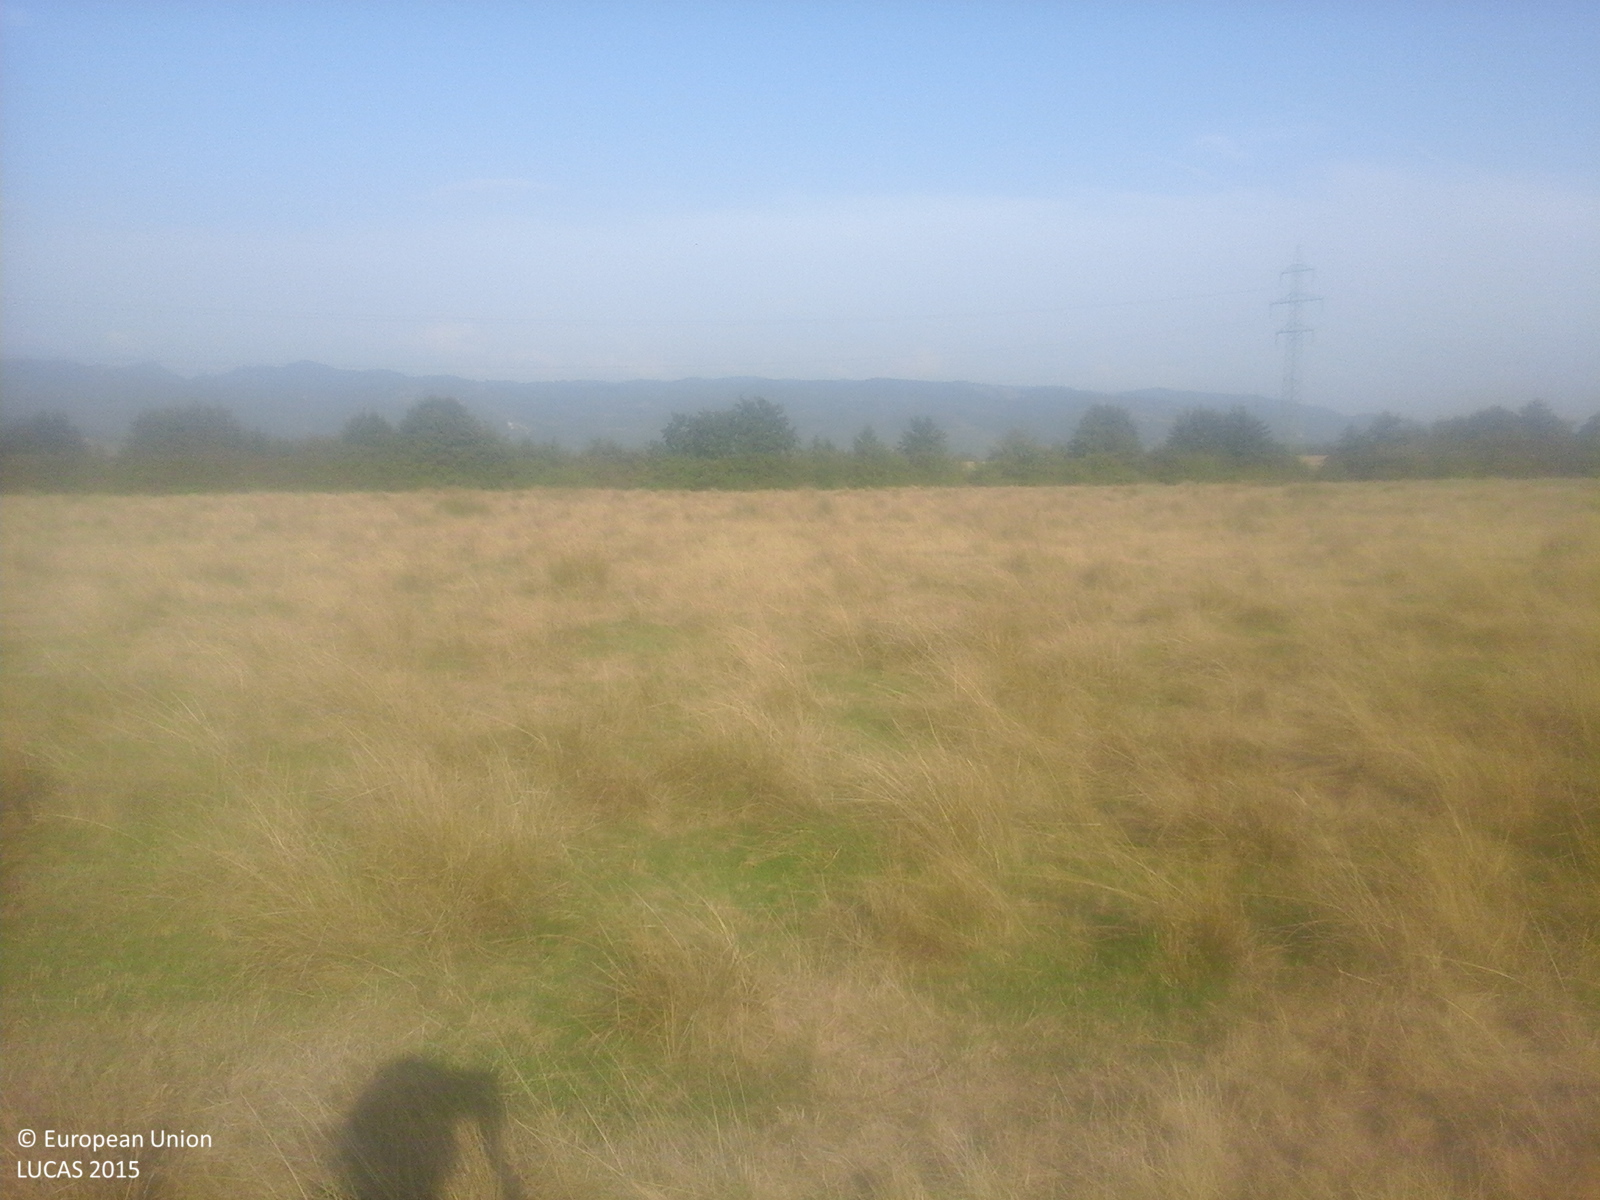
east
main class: Grassland
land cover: Grassland without tree/shrub cover
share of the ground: > 75 %
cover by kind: herbaceous plants 100 %
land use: Agriculture (excluding fallow land and kitchen gardens)
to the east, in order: Grassland without tree/shrub cover; Abandoned hedges; Rivers and streams; Abandoned hedges; Grassland with sparse tree/shrub cover; Grassland without tree/shrub cover; Electric lines; Grassland without tree/shrub cover
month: September
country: RO
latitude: 45.4909
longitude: 23.0669
